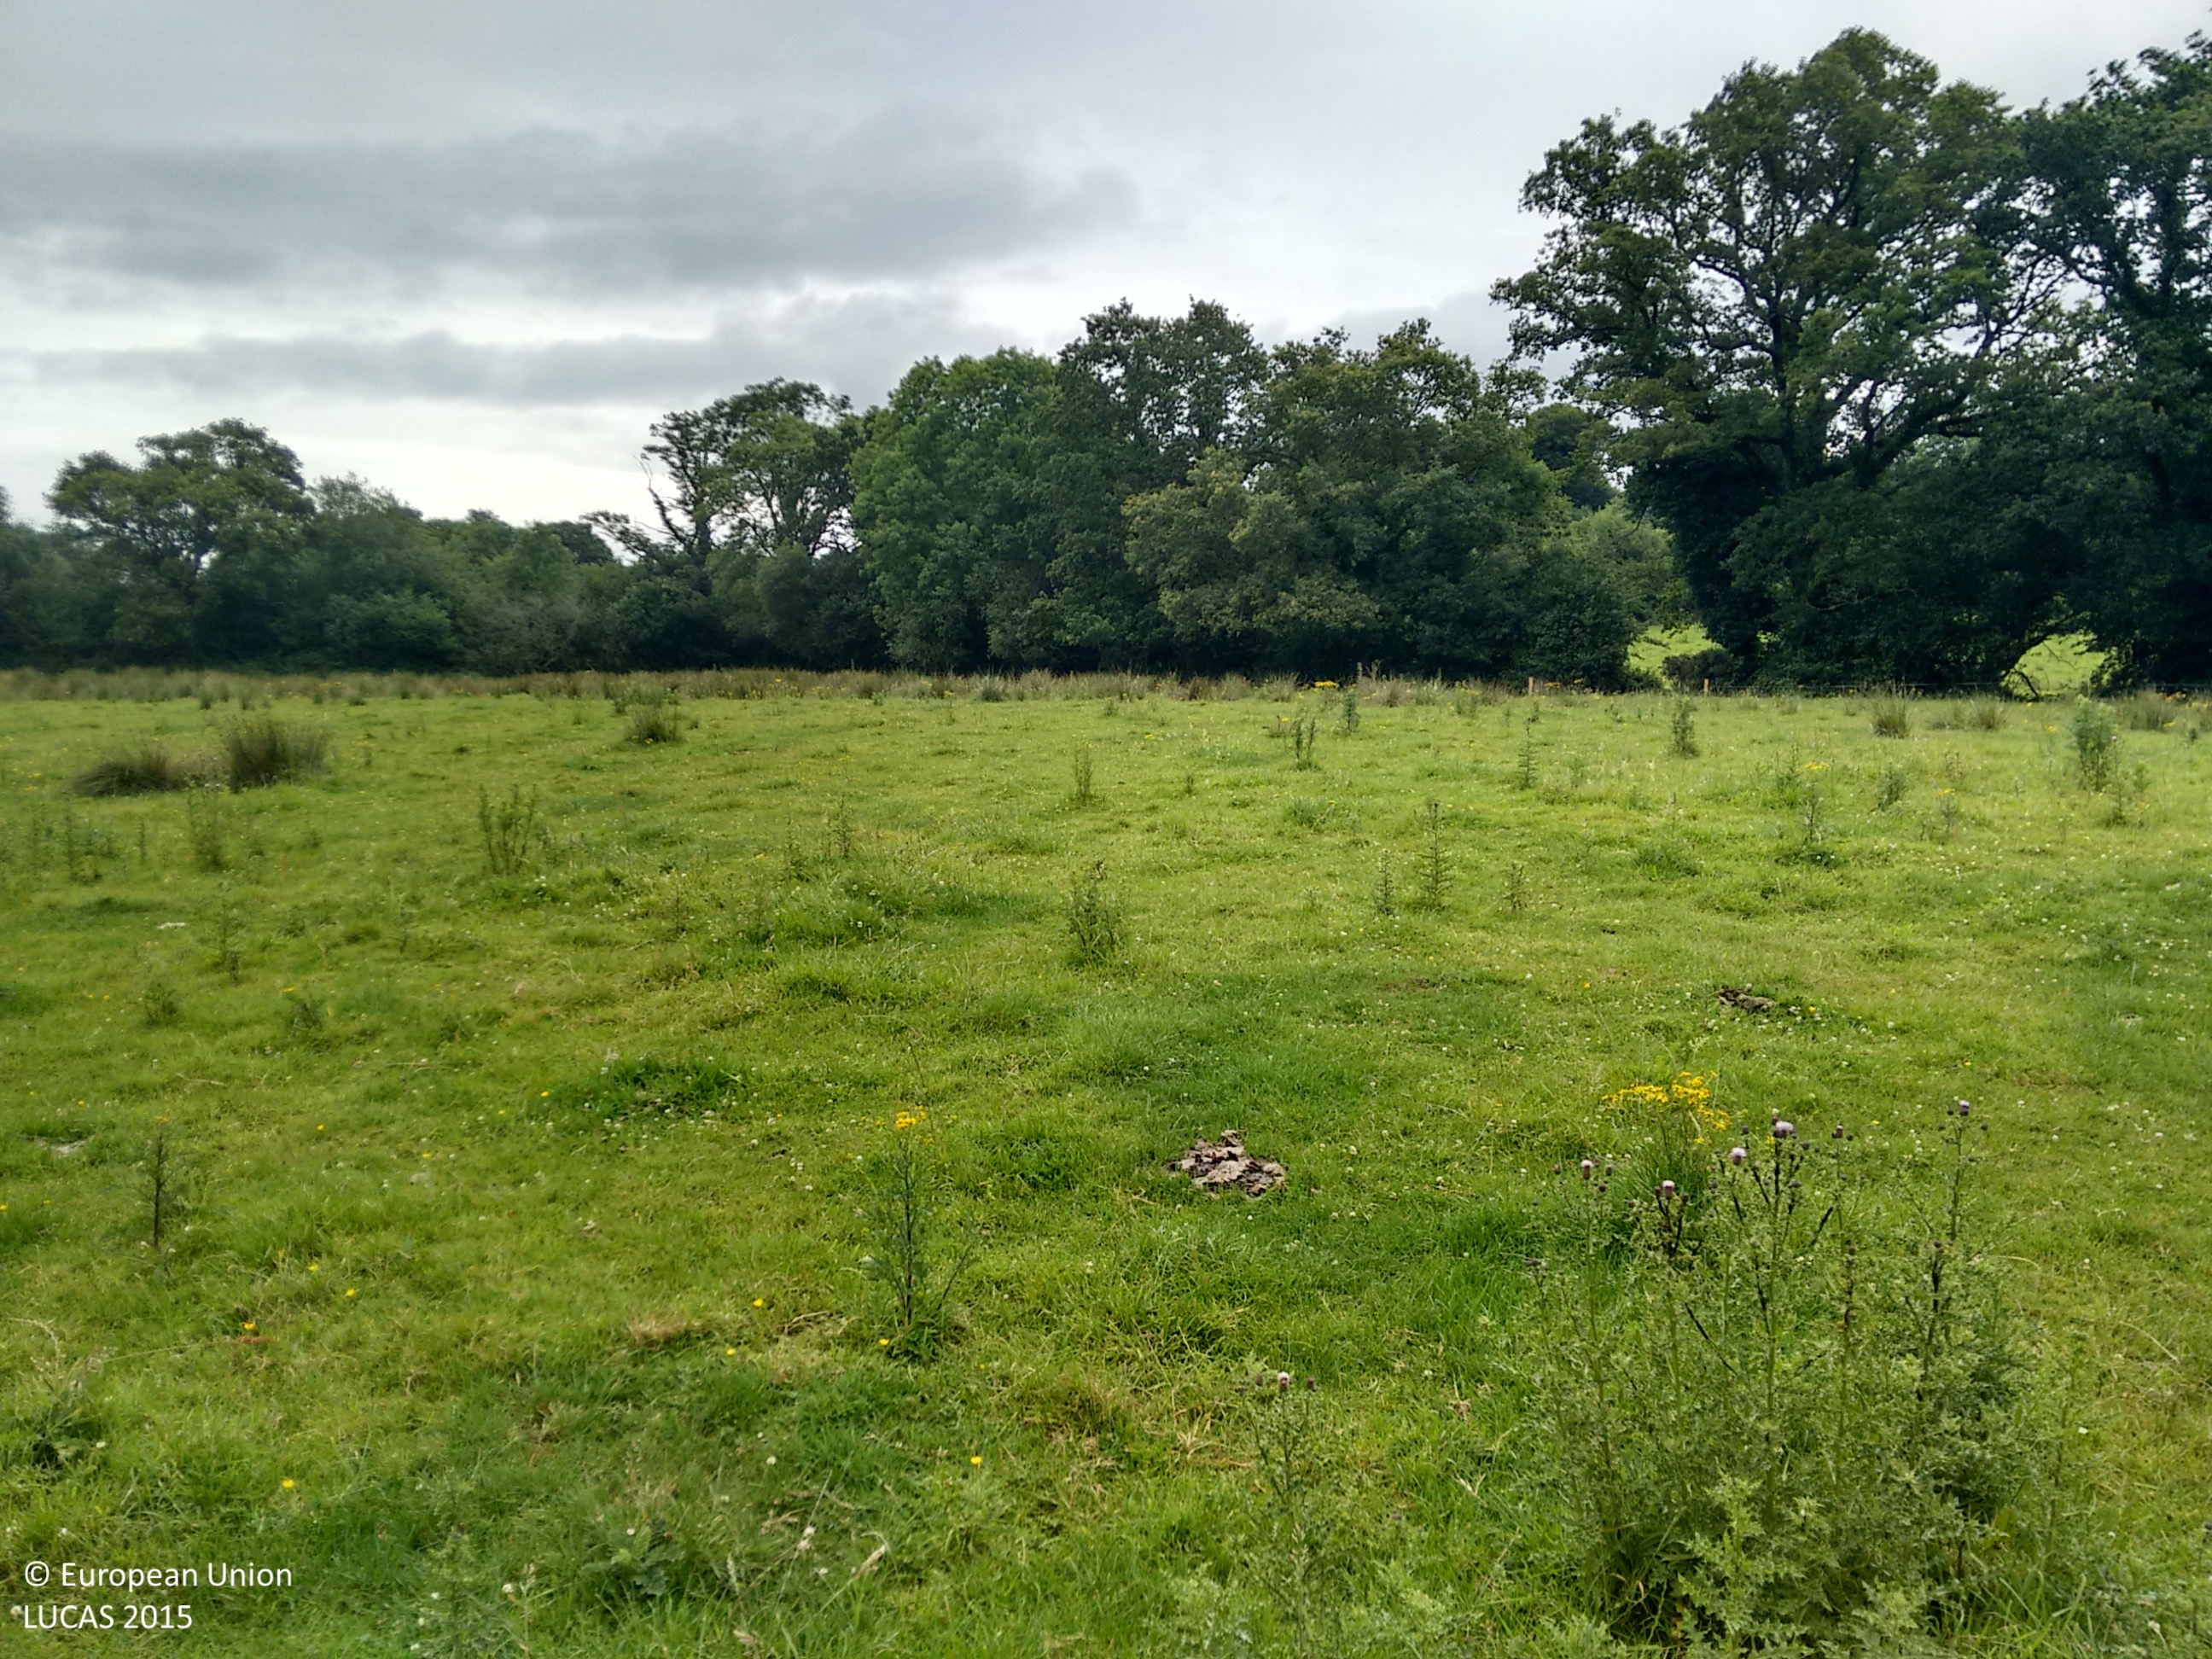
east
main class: Grassland
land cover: Grassland without tree/shrub cover
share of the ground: > 75 %
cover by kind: herbaceous plants 100 %
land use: Agriculture (excluding fallow land and kitchen gardens)
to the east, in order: Grassland without tree/shrub cover; Fences; Abandoned hedges; Fences; Ditches and canals; Grassland without tree/shrub cover; Abandoned hedges; Ditches and canals; Fences; Abandoned hedges; Fences; Grassland without tree/shrub cover
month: July
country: IE
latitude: 52.4123
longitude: -8.1922
